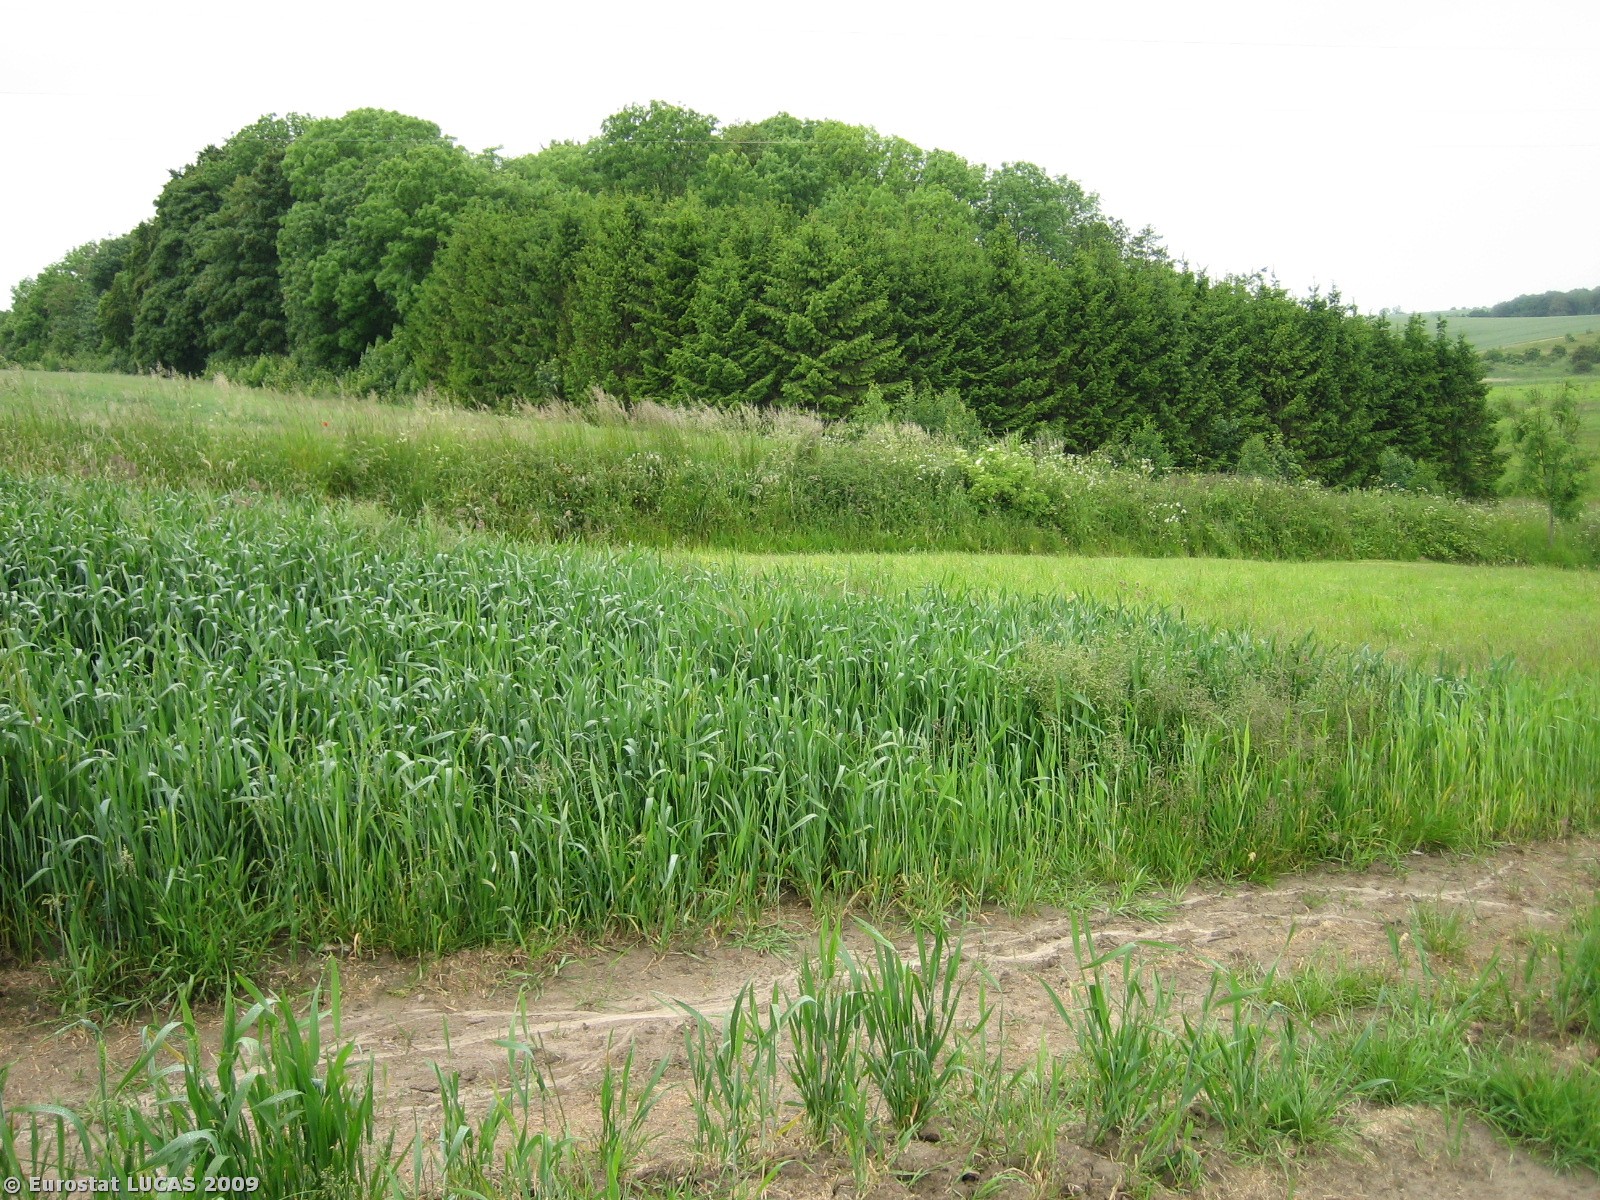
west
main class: Cropland
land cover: Common wheat
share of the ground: > 75 %
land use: Agriculture (excluding fallow land and kitchen gardens)
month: June
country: DK
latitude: 56.0078
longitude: 10.2083
